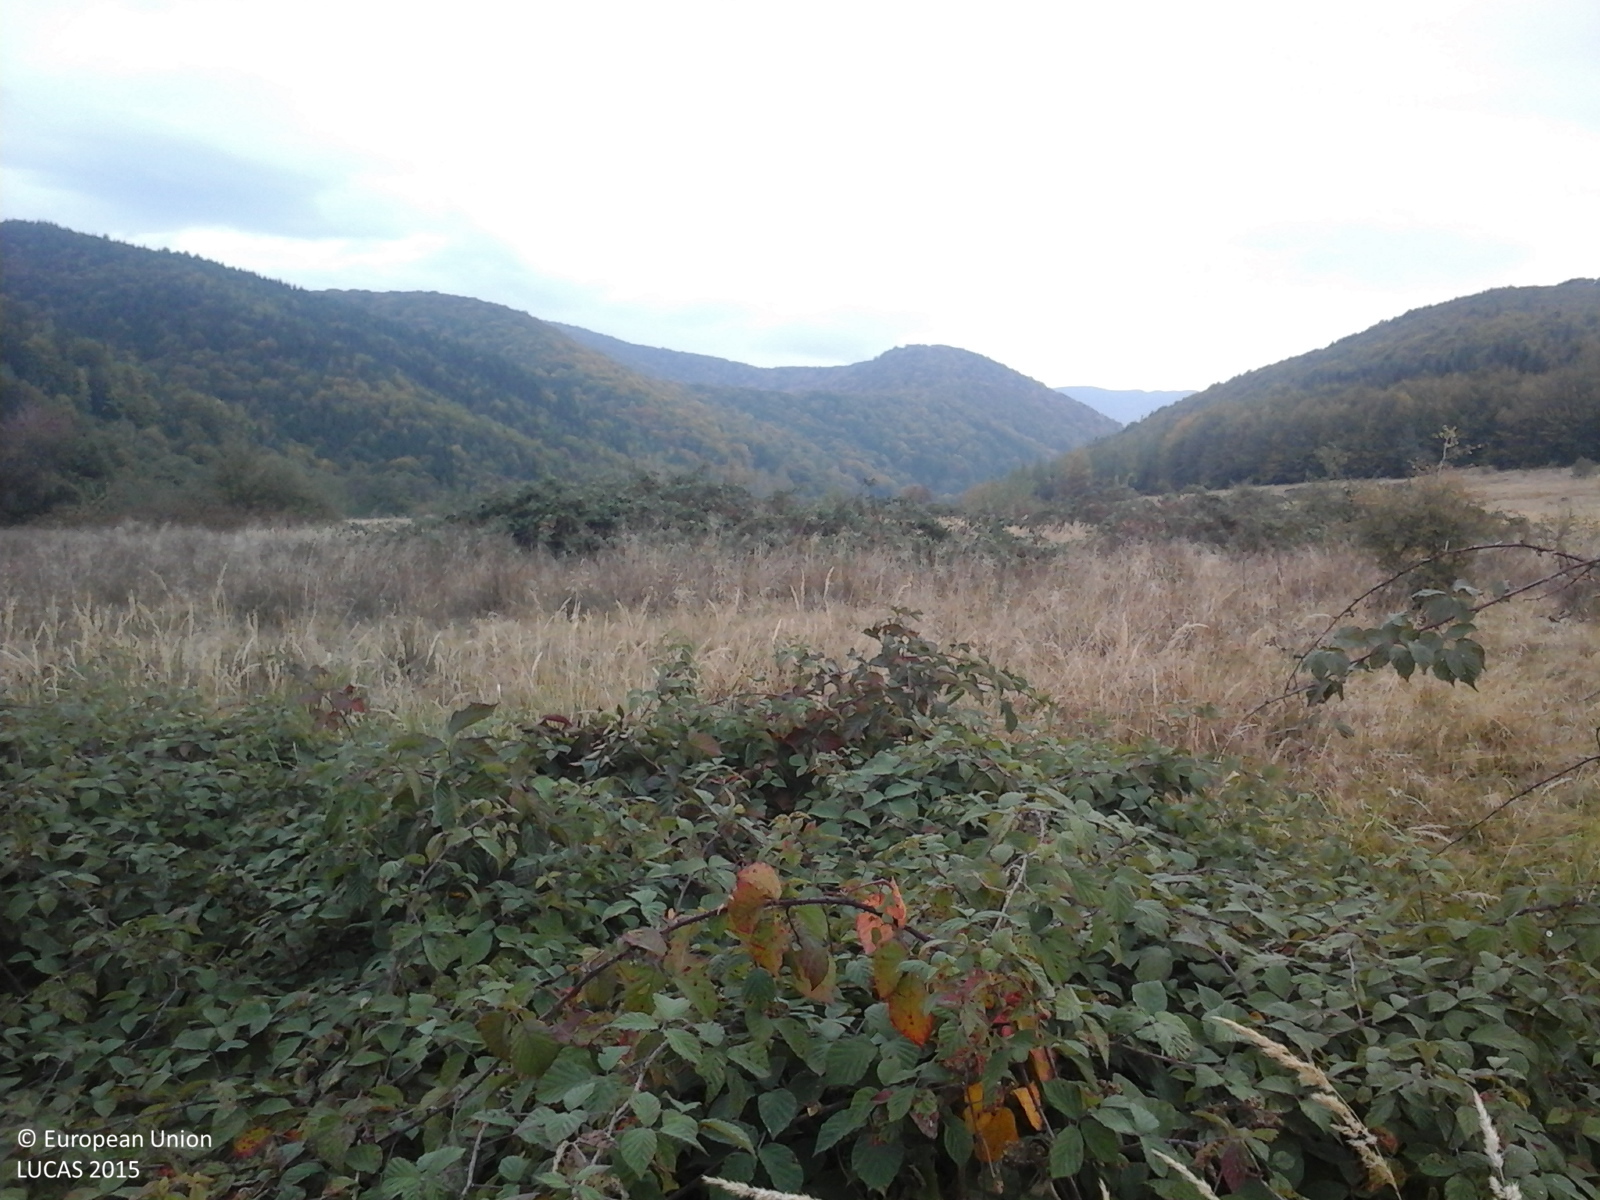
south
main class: Shrubland
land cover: Shrubland without tree cover
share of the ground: > 75 %
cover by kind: shrubs 100 %
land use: Semi-natural and natural areas not in use
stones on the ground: < 10 %
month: October
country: RO
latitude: 45.7096
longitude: 25.1101
